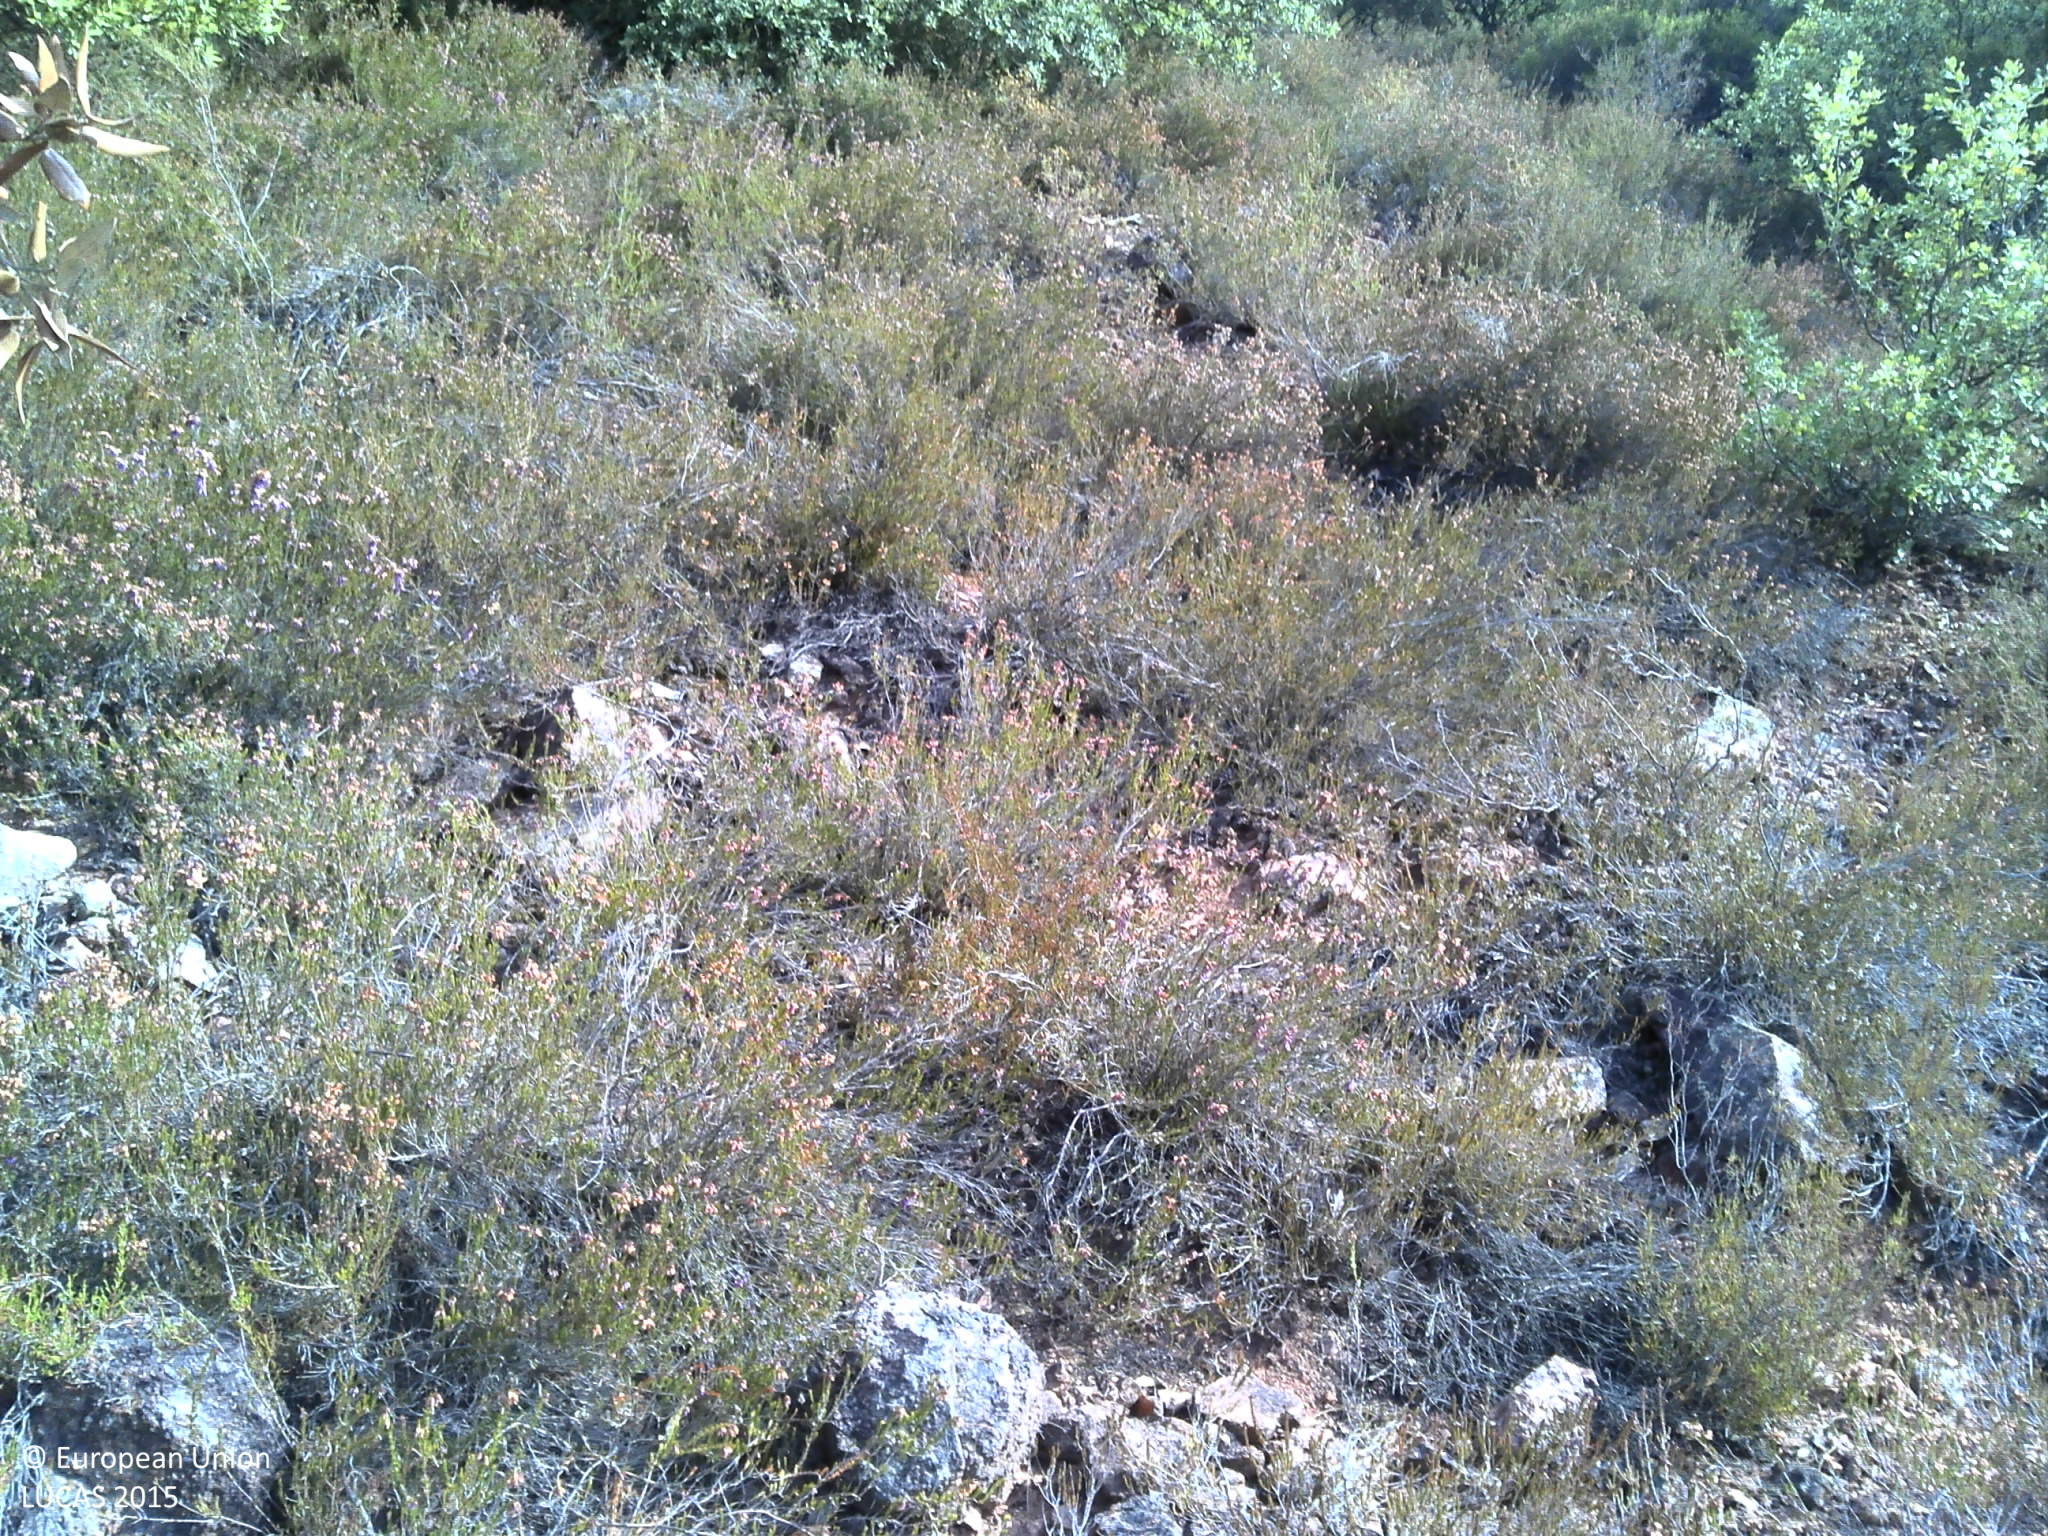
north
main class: Shrubland
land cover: Shrubland with sparse tree cover
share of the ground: > 75 %
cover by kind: shrubs 70 %, consolidated bare surface 25 %, broadleaved forest trees 5 %
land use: Semi-natural and natural areas not in use
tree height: < 5 m
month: July
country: FR
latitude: 43.7254
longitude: 3.1428
